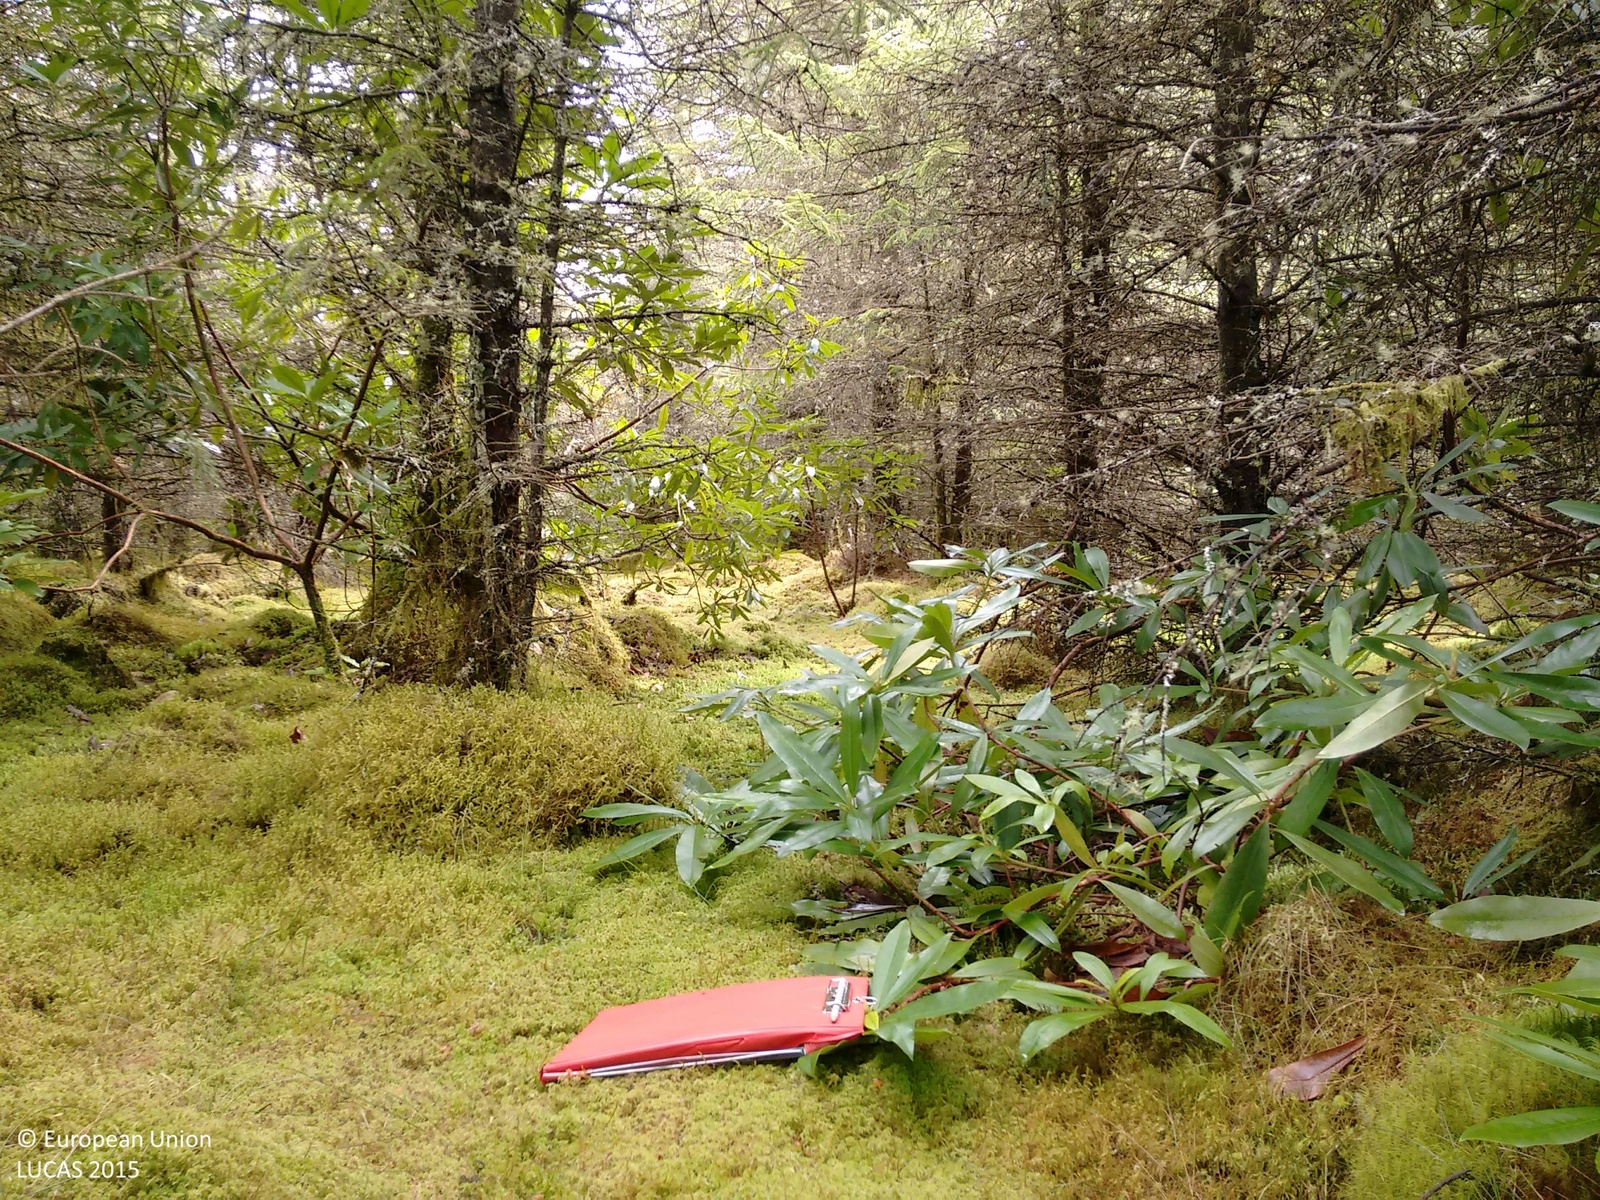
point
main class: Woodland
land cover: Spruce dominated coniferous woodland
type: exotic forest
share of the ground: > 75 %
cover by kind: coniferous forest trees 100 %
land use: Forestry
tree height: > 5 m
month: June
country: GB
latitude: 56.0991
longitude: -5.5068
